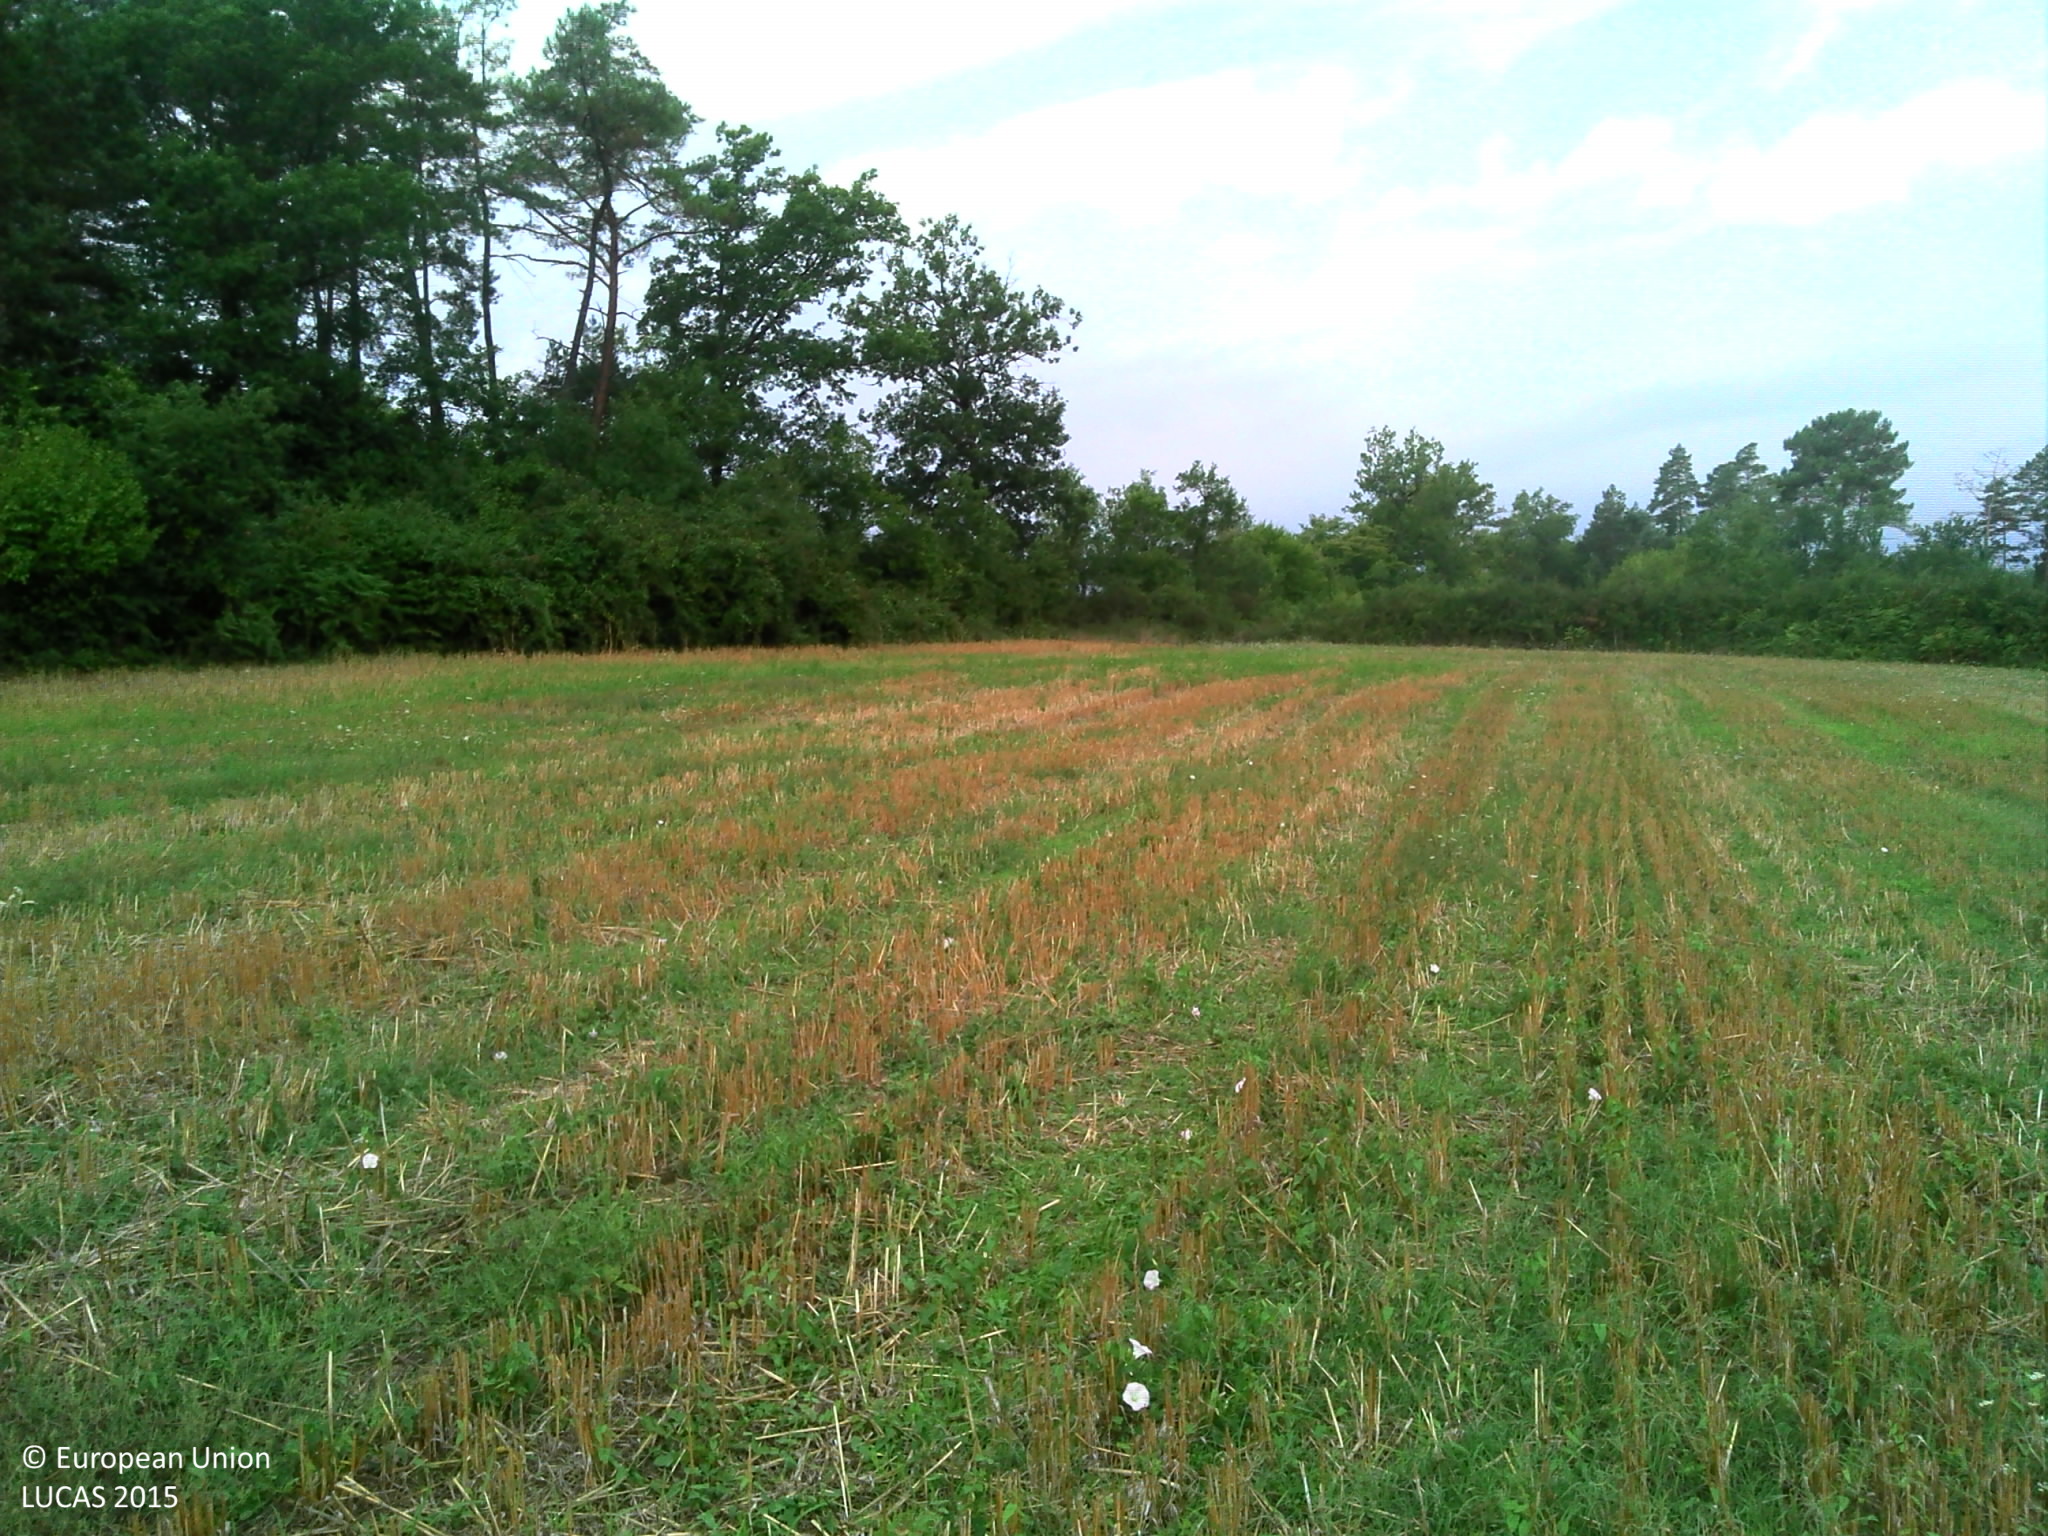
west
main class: Cropland
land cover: Temporary grasslands
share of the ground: > 75 %
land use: Agriculture (excluding fallow land and kitchen gardens)
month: August
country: FR
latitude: 45.3881
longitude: 0.7550
